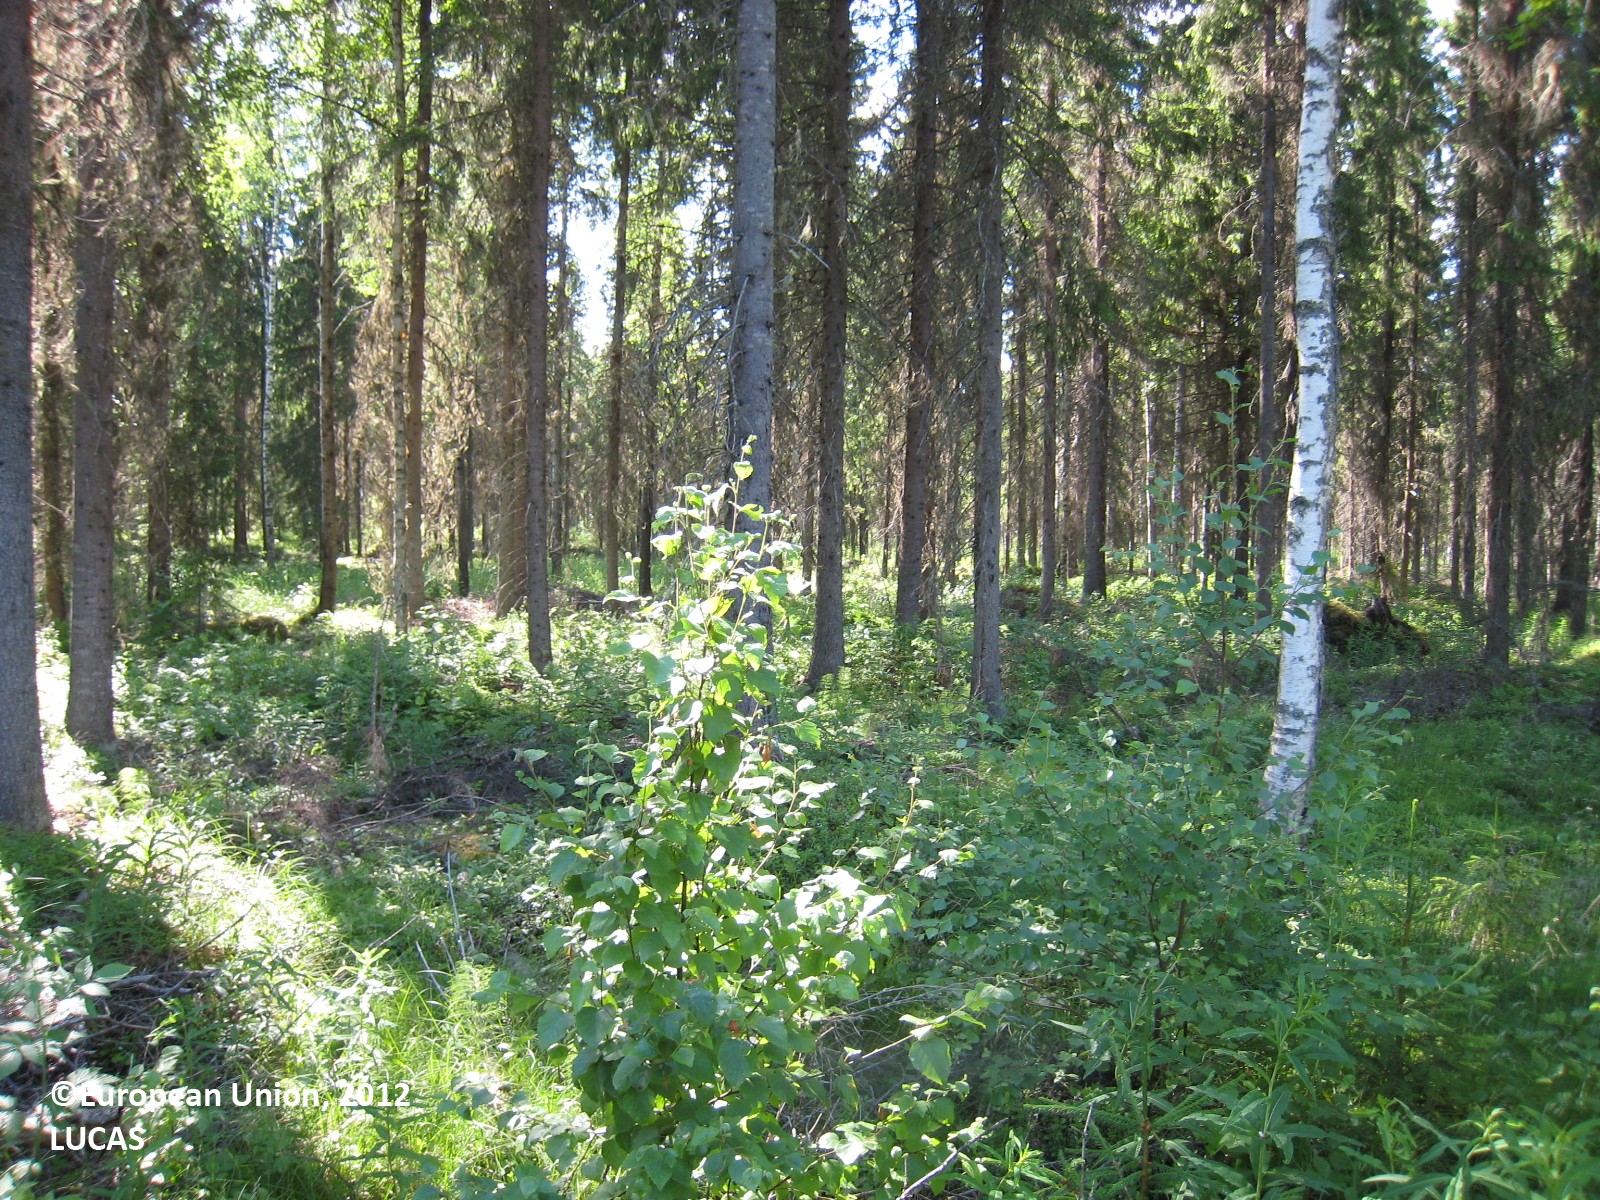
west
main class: Woodland
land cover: Spruce dominated coniferous woodland
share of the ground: 25 - 50 %
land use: Forestry
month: July
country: FI
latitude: 62.6036
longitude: 26.1194
